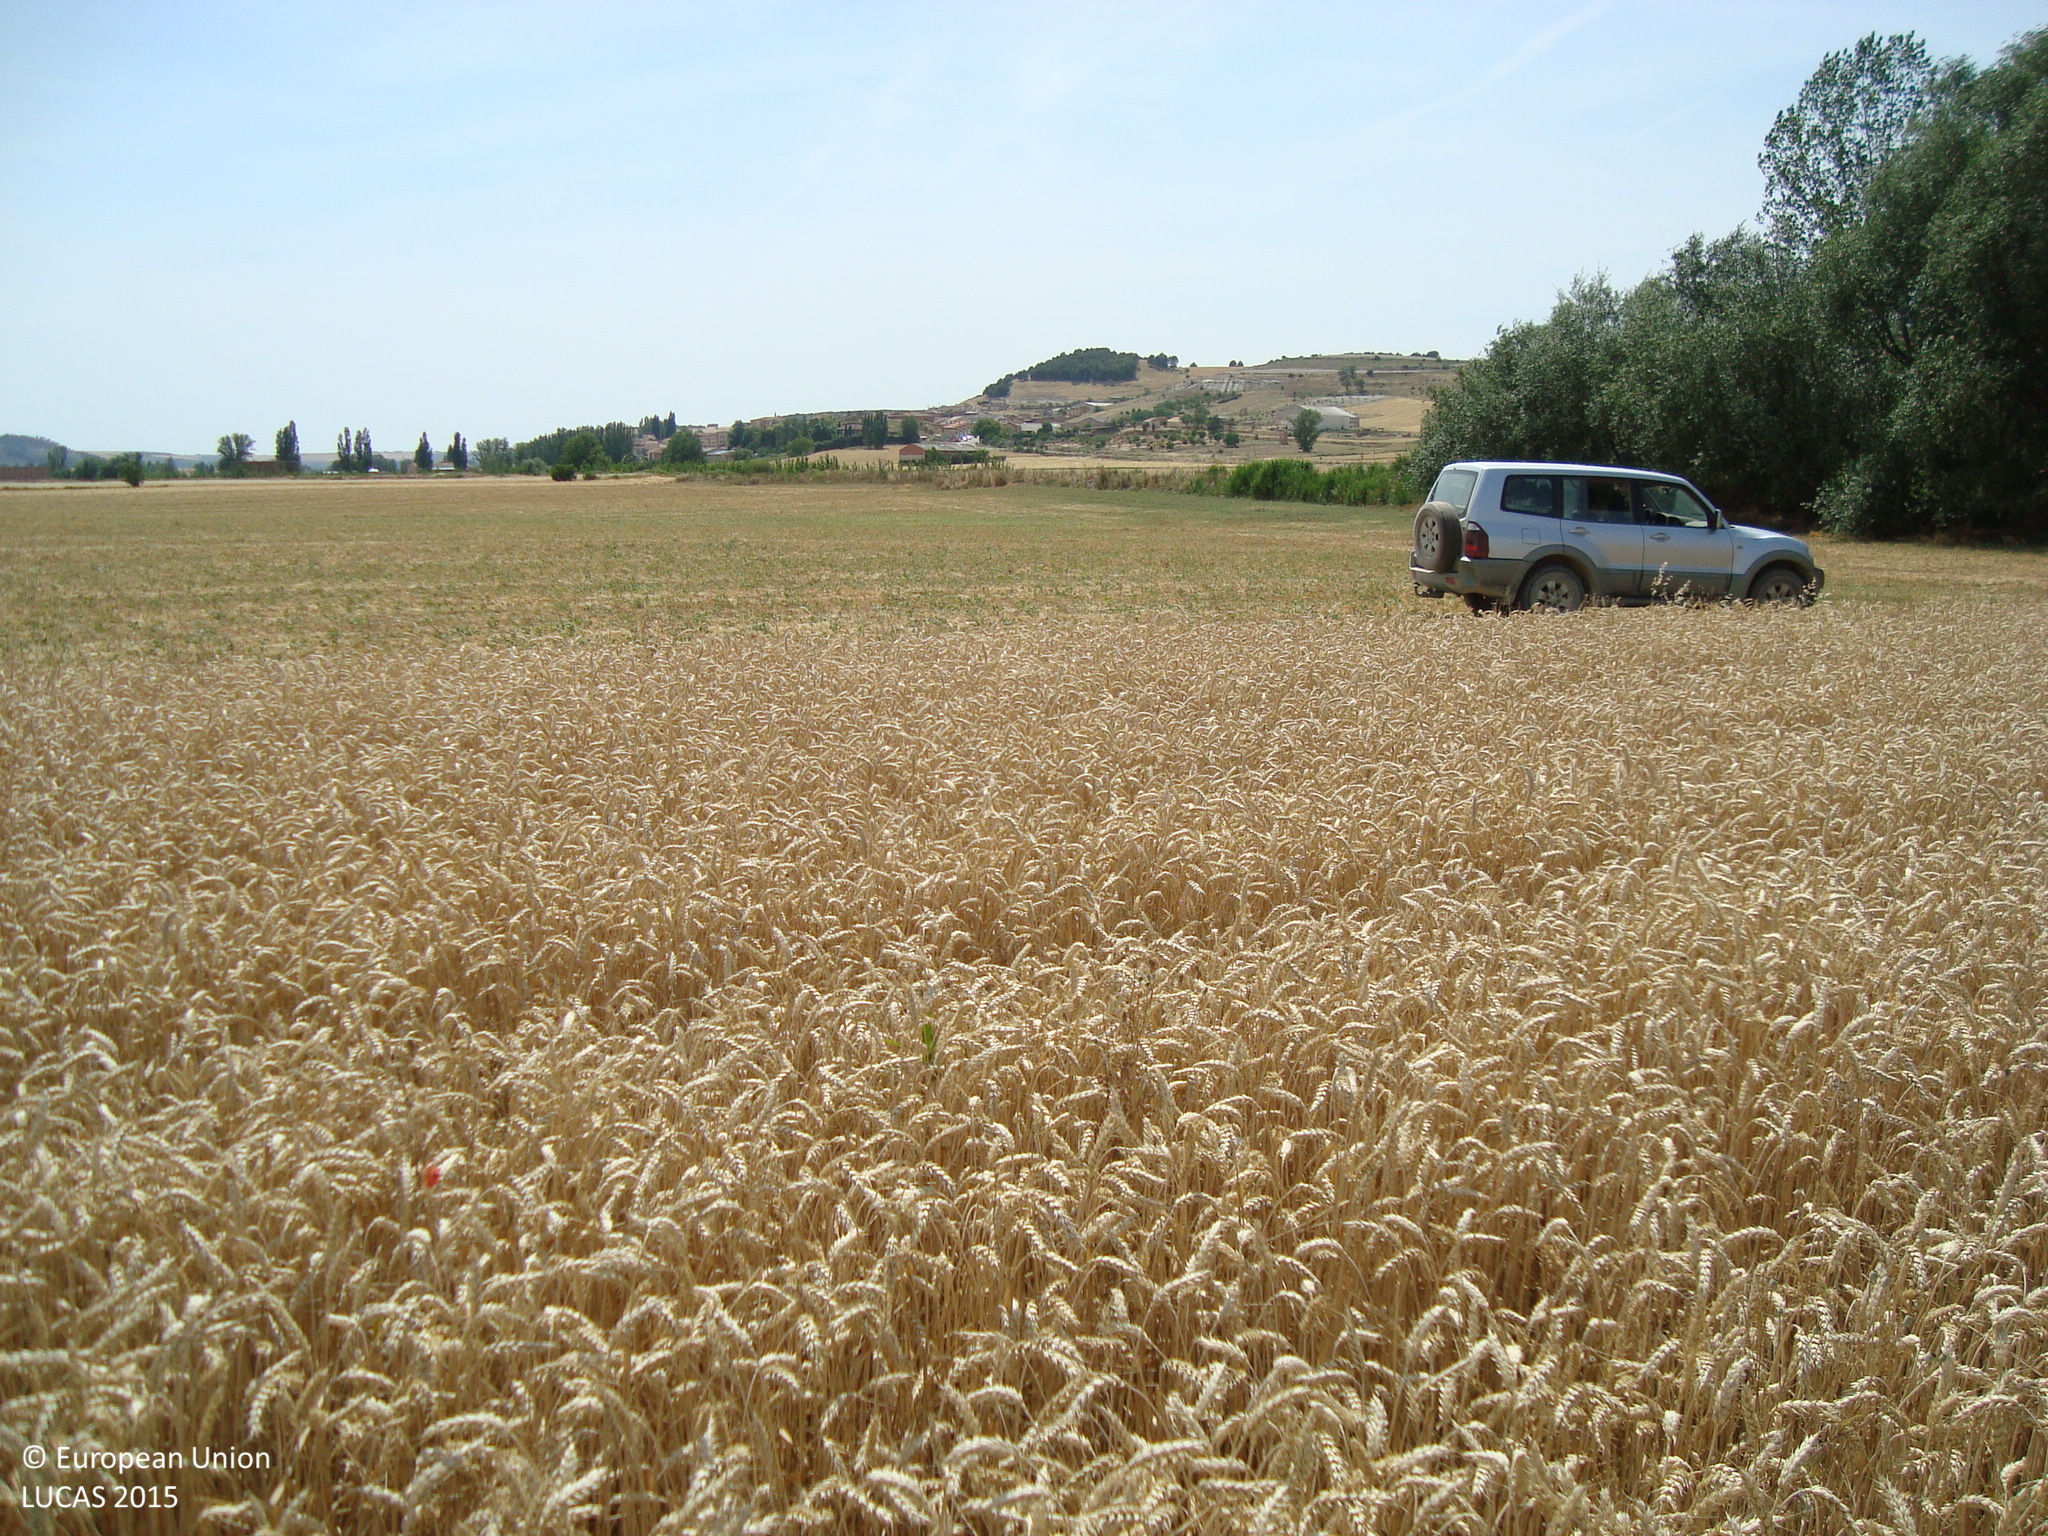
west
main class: Cropland
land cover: Common wheat
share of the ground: > 75 %
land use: Agriculture (excluding fallow land and kitchen gardens)
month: July
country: ES
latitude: 41.7965
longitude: -4.0559
